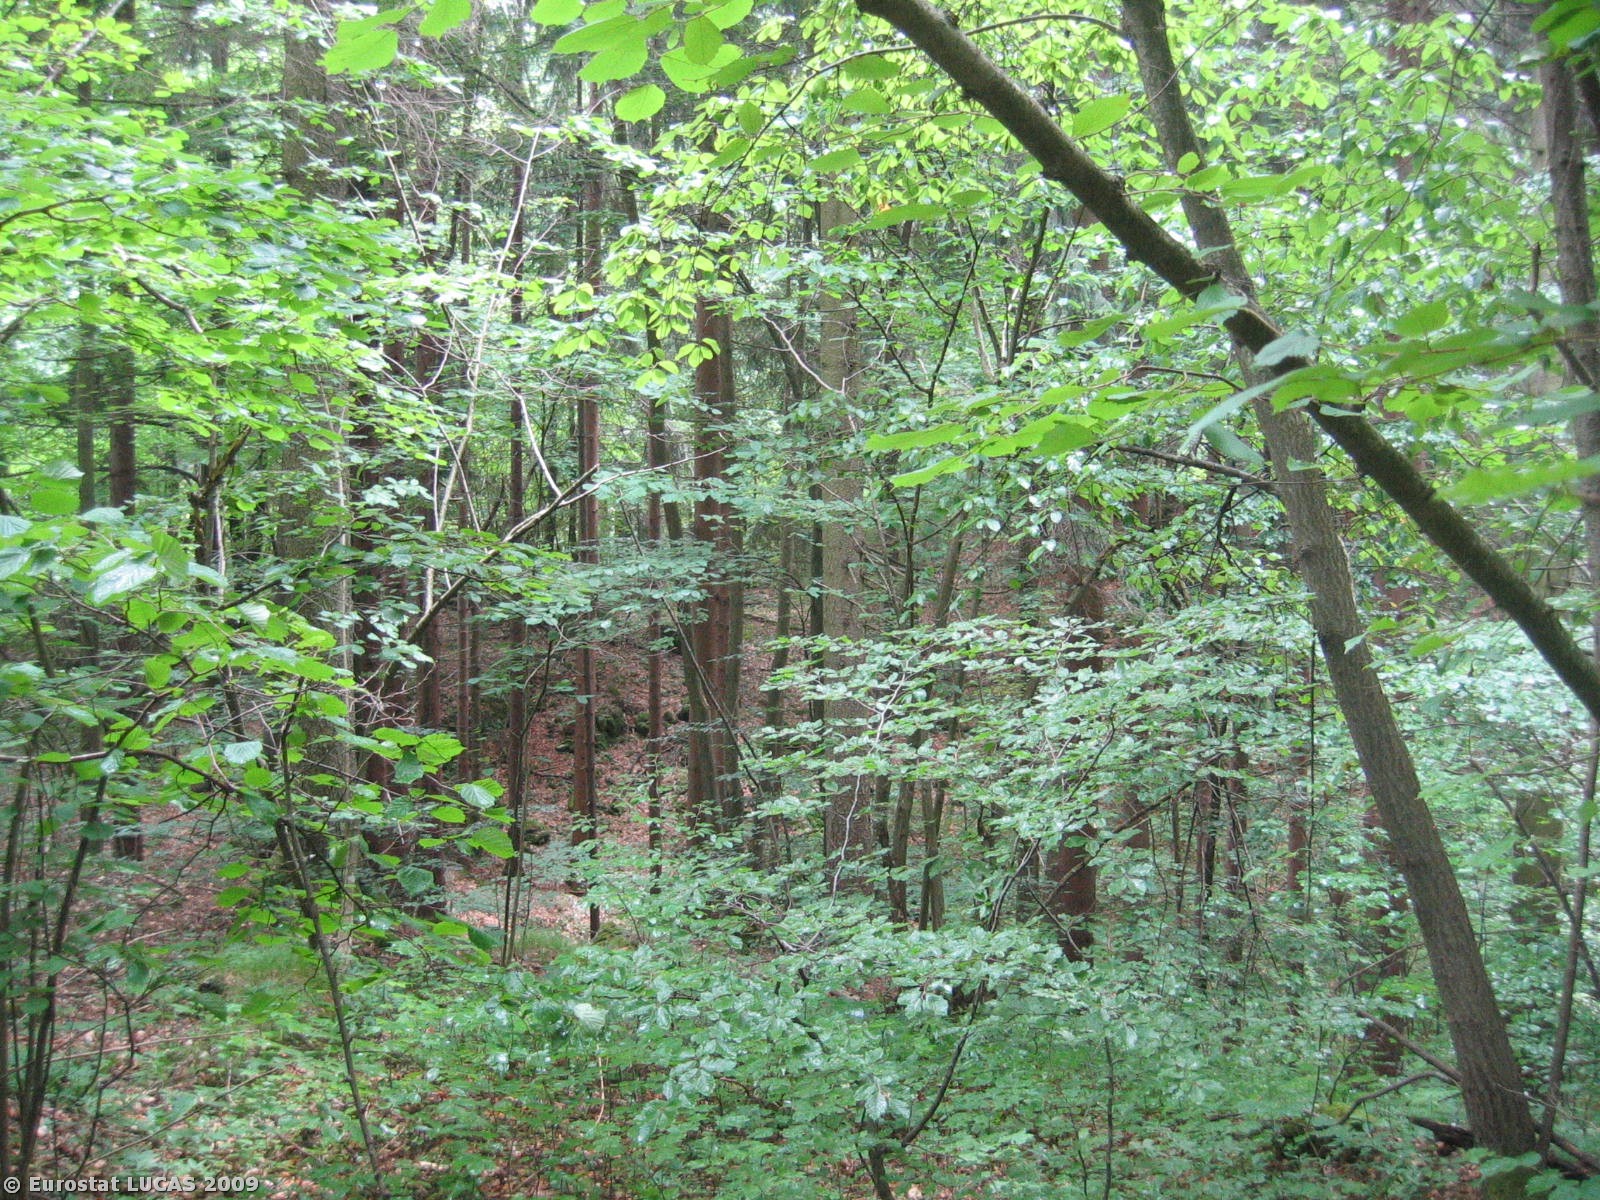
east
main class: Woodland
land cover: Mixed woodland
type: beech forest
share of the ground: > 75 %
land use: Forestry
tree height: > 5 m
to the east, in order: Mixed woodland; Ditches and canals; Mixed woodland; Tracks; Mixed woodland; Grassland with sparse tree/shrub cover; Mixed woodland; Grassland with sparse tree/shrub cover; Mixed woodland; Shrubland with sparse tree cover; Tracks; Grassland with sparse tree/shrub cover; Fences; Grassland with sparse tree/shrub cover
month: July
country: SI
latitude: 45.9975
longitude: 14.2184
